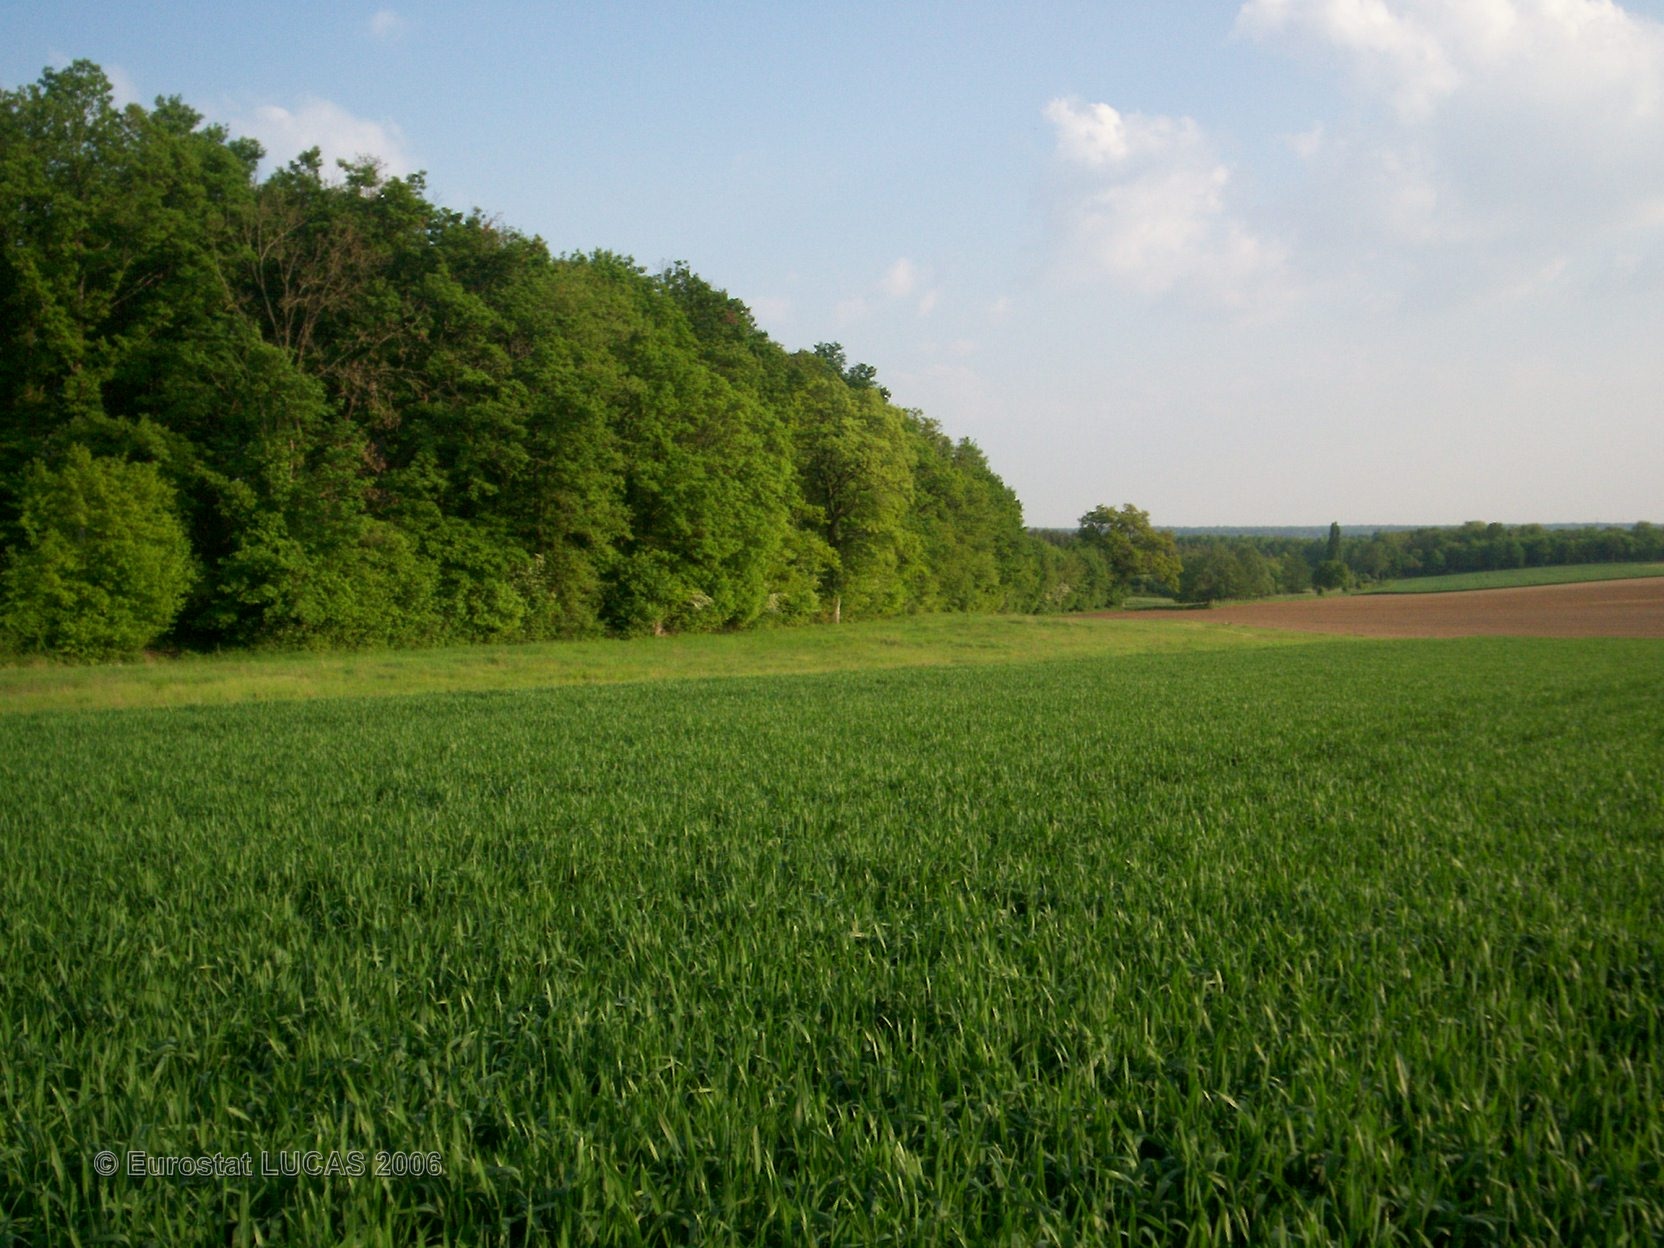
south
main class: Cropland
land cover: Common wheat
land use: Agriculture (excluding fallow land and kitchen gardens)
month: May
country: FR
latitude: 47.5831
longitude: 0.3639
